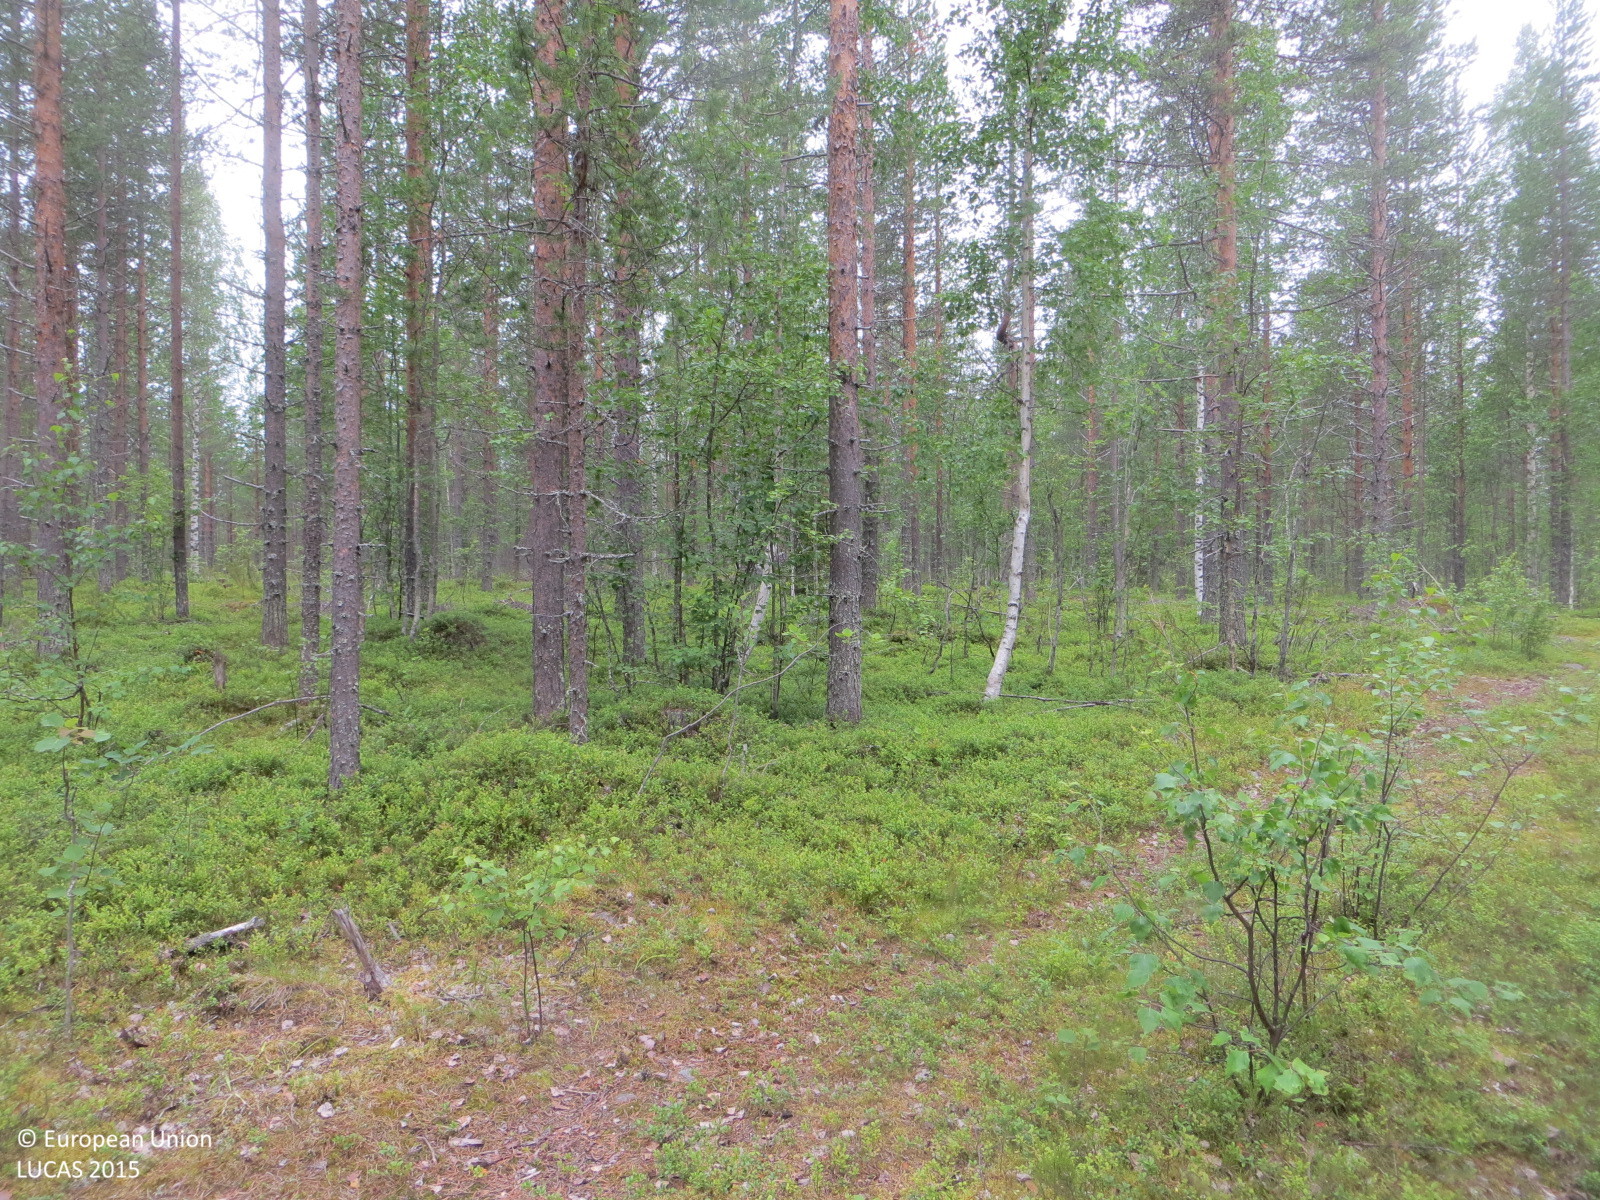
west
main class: Woodland
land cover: Pine dominated coniferous woodland
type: boreal forest
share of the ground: 50 - 75 %
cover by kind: coniferous forest trees 50 %, shrubs 40 %, broadleaved forest trees 10 %
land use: Forestry
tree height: > 5 m
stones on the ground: 10 - 25 %
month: July
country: FI
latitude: 66.3739
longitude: 24.1956
